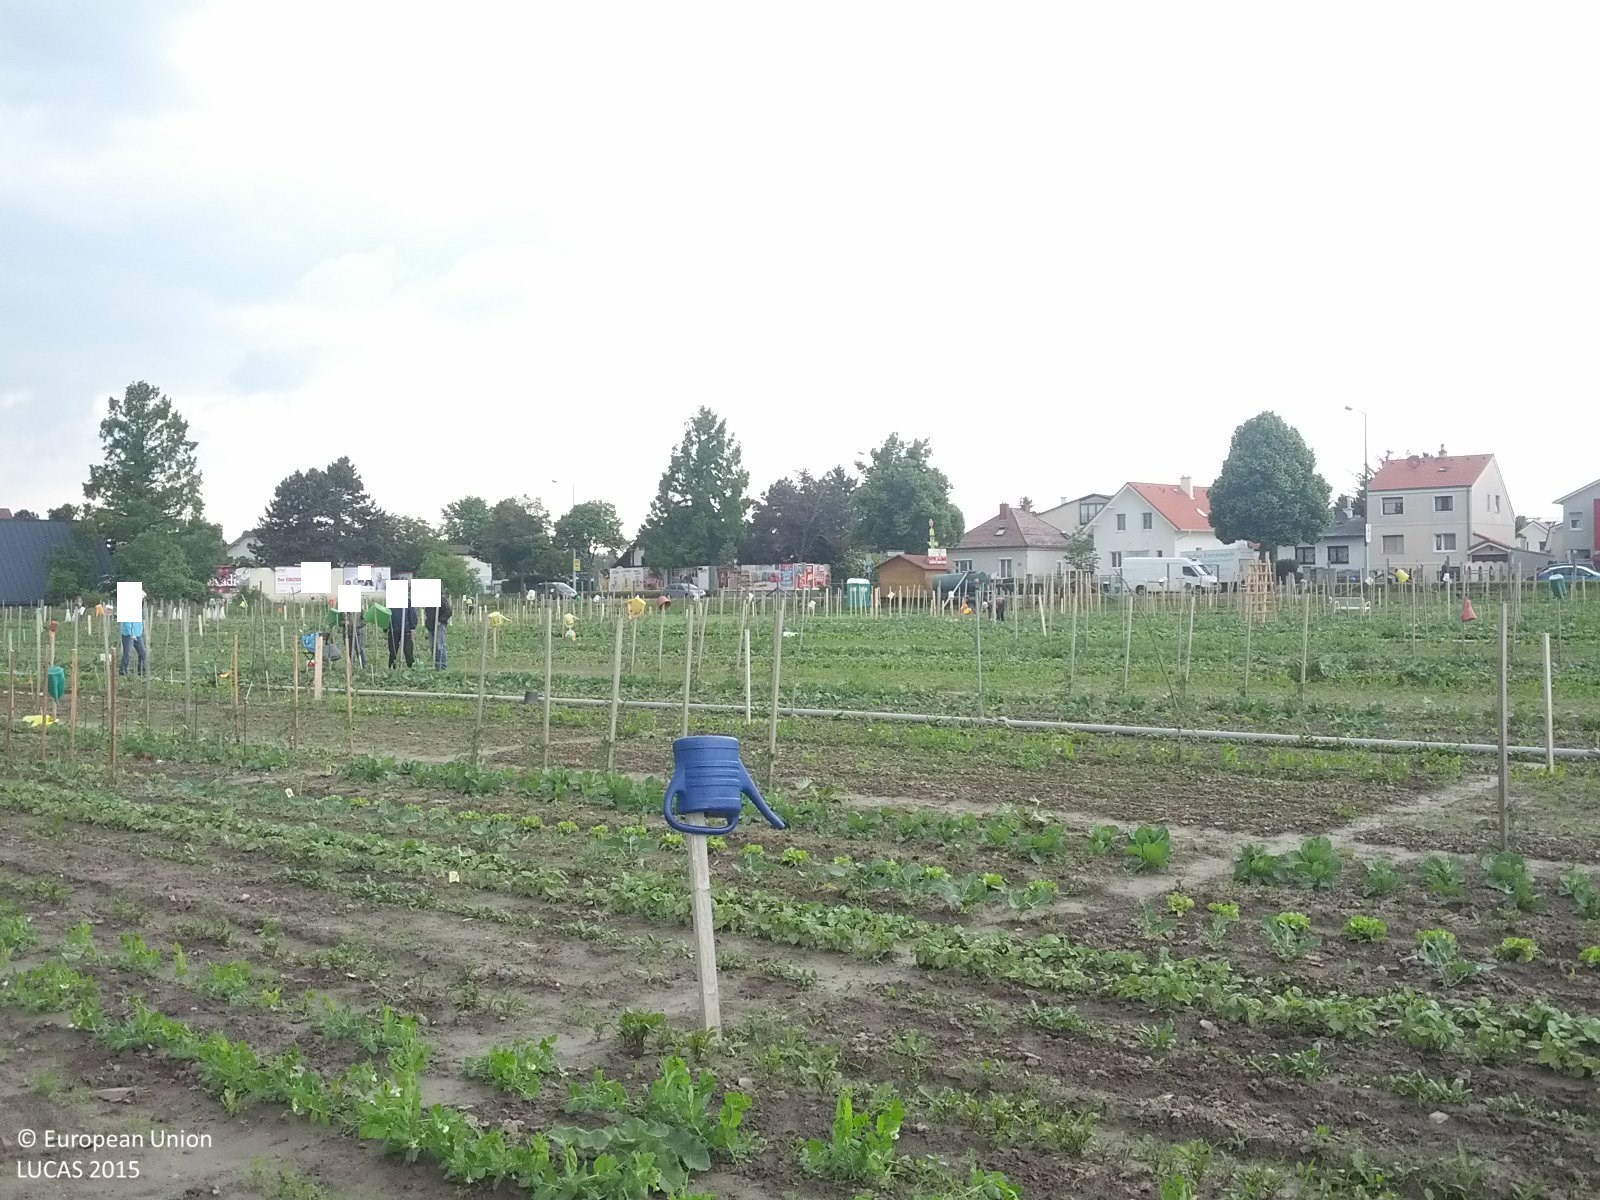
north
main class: Cropland
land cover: Other fresh vegetables
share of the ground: 25 - 50 %
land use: Kitchen garden
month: May
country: AT
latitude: 48.2103
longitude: 16.5324
